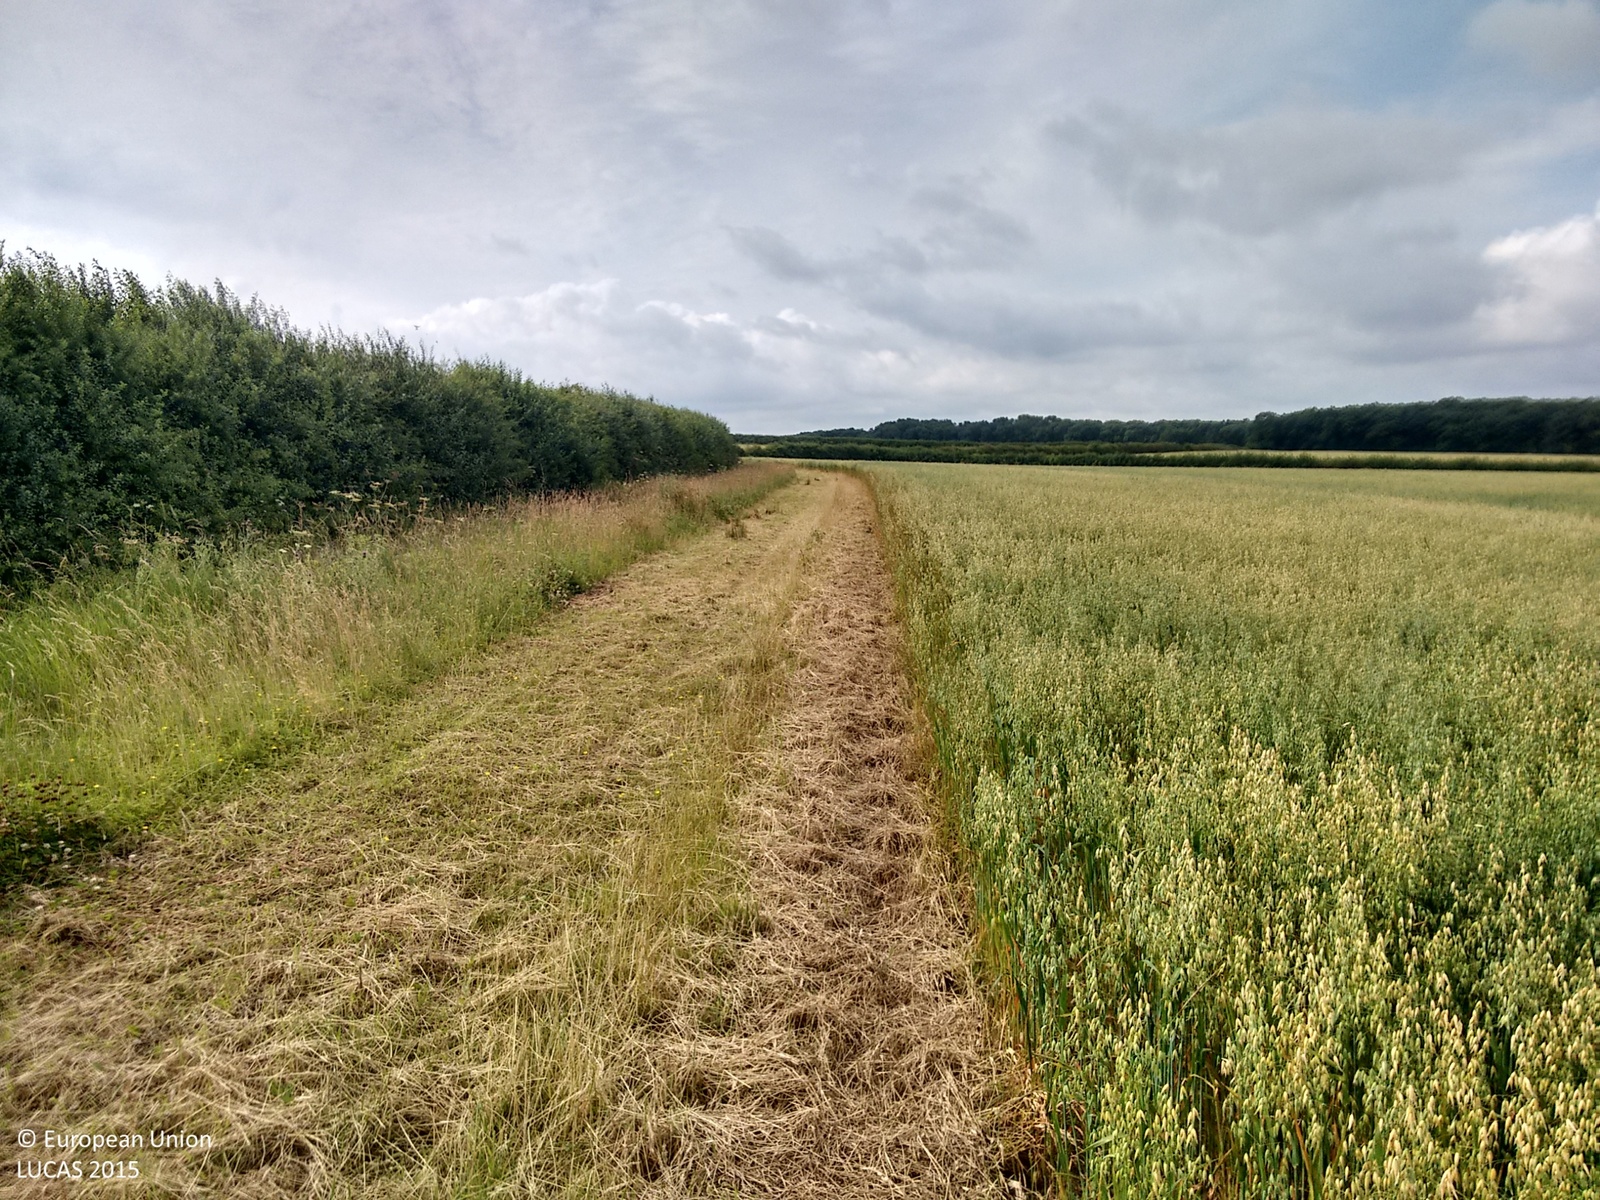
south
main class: Cropland
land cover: Oats
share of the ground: > 75 %
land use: Agriculture (excluding fallow land and kitchen gardens)
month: July
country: GB
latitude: 53.1077
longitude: -0.9023
